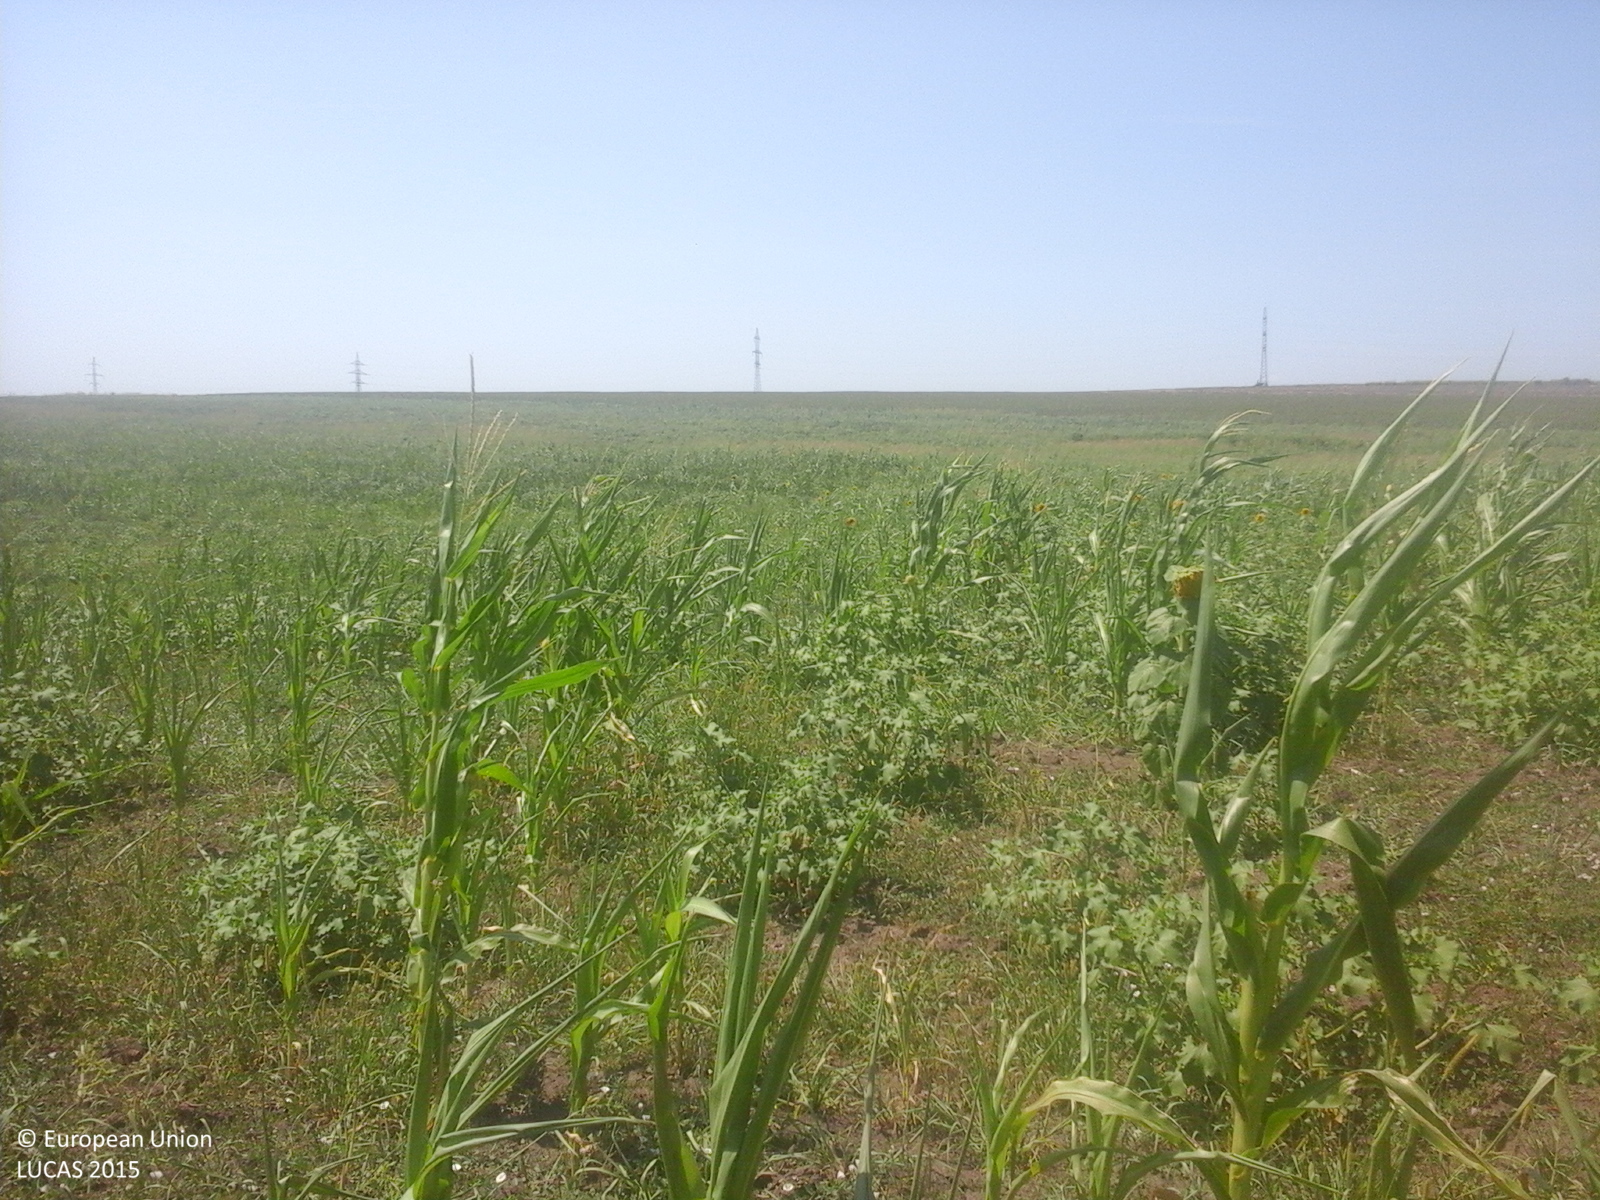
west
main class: Cropland
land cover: Maize
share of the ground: 50 - 75 %
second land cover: Spontaneously vegetated surfaces
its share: 25 - 50 %
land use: Agriculture (excluding fallow land and kitchen gardens)
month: July
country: RO
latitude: 46.6575
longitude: 27.9644
